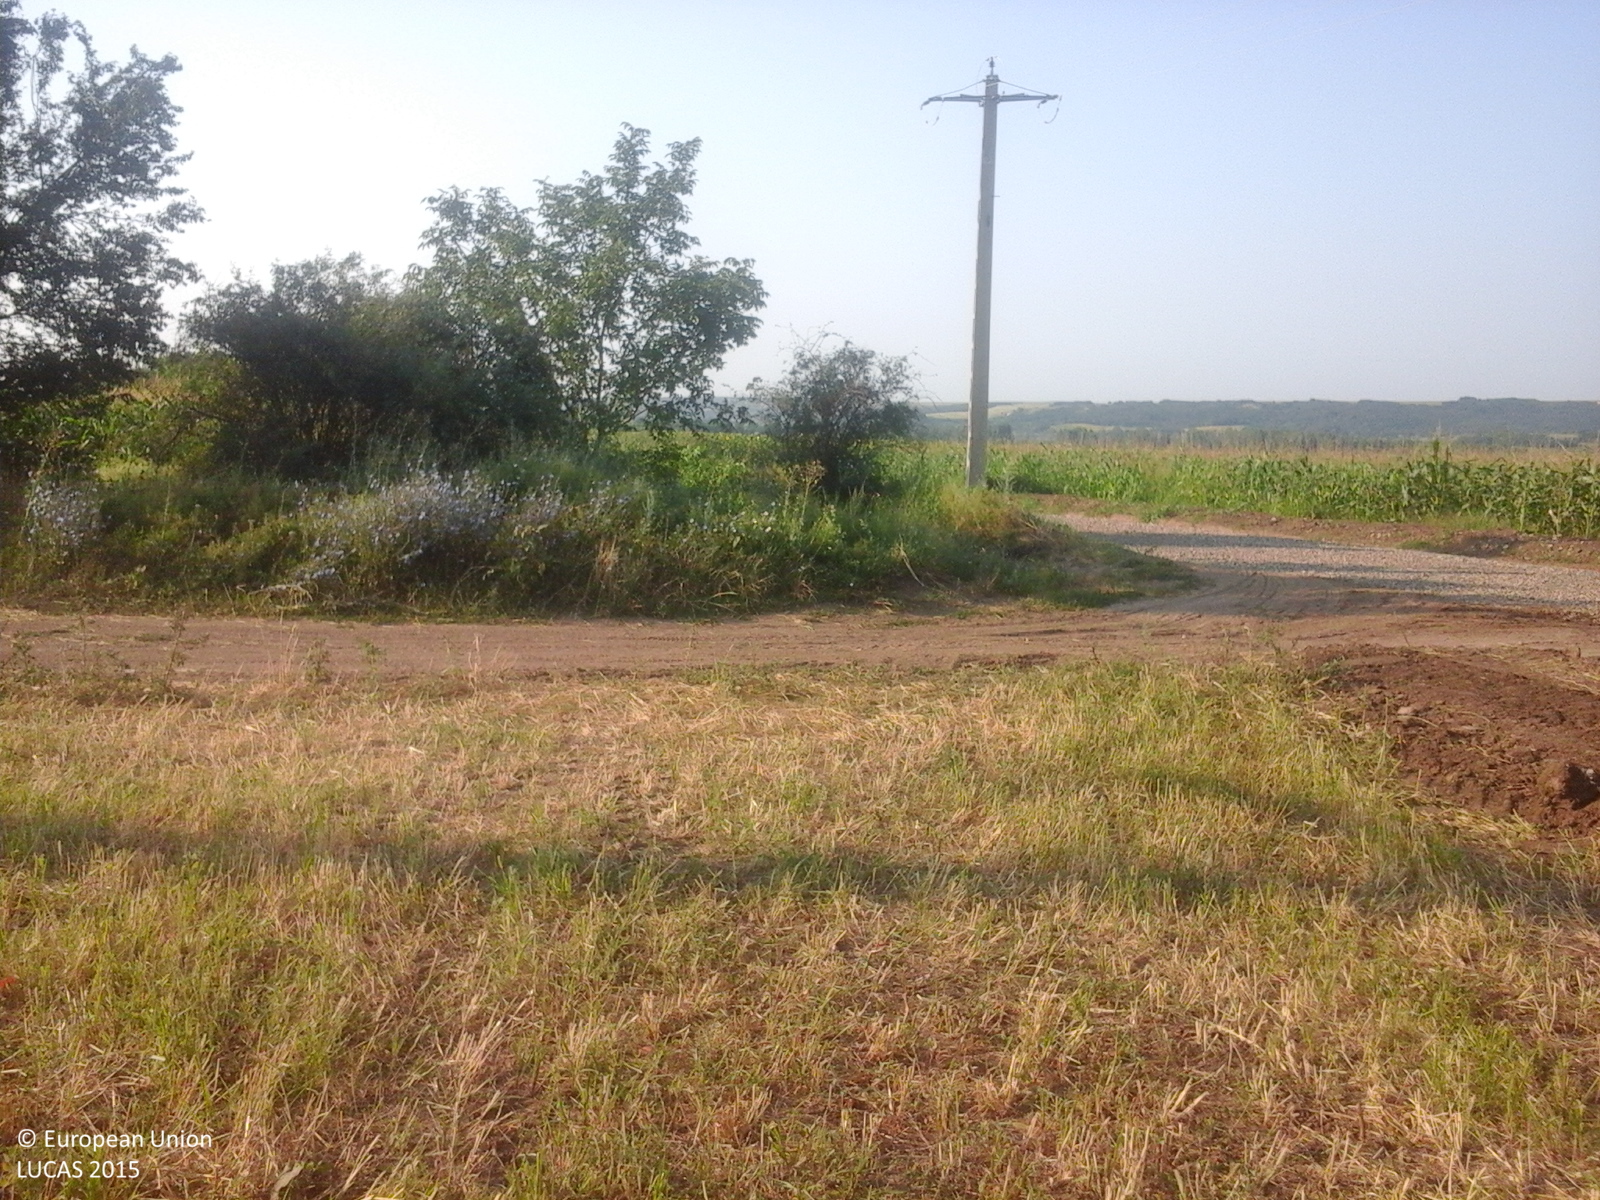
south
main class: Cropland
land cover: Durum wheat
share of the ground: > 75 %
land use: Agriculture (excluding fallow land and kitchen gardens)
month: July
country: RO
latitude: 45.9918
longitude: 28.0833
